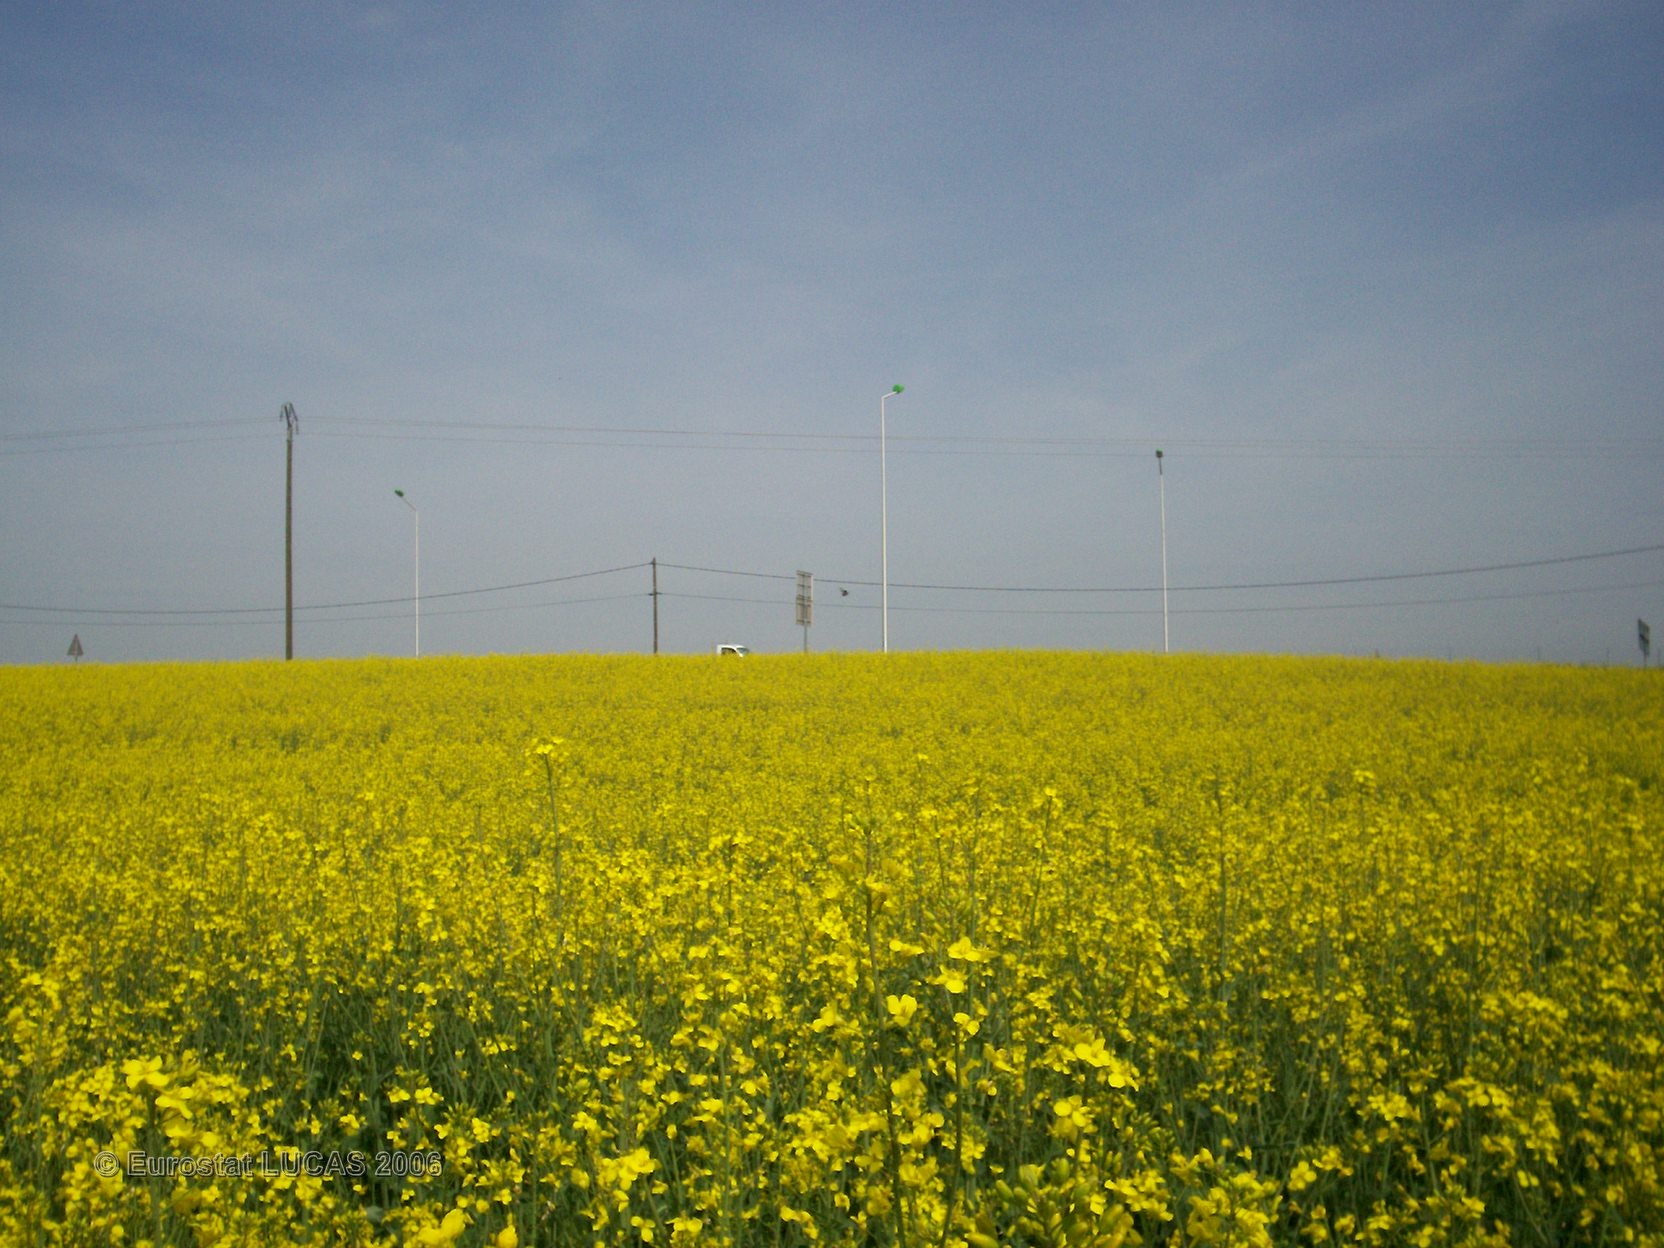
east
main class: Cropland
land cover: Rape and turnip rape
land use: Agriculture (excluding fallow land and kitchen gardens)
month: May
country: FR
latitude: 46.0222
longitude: 4.7195
